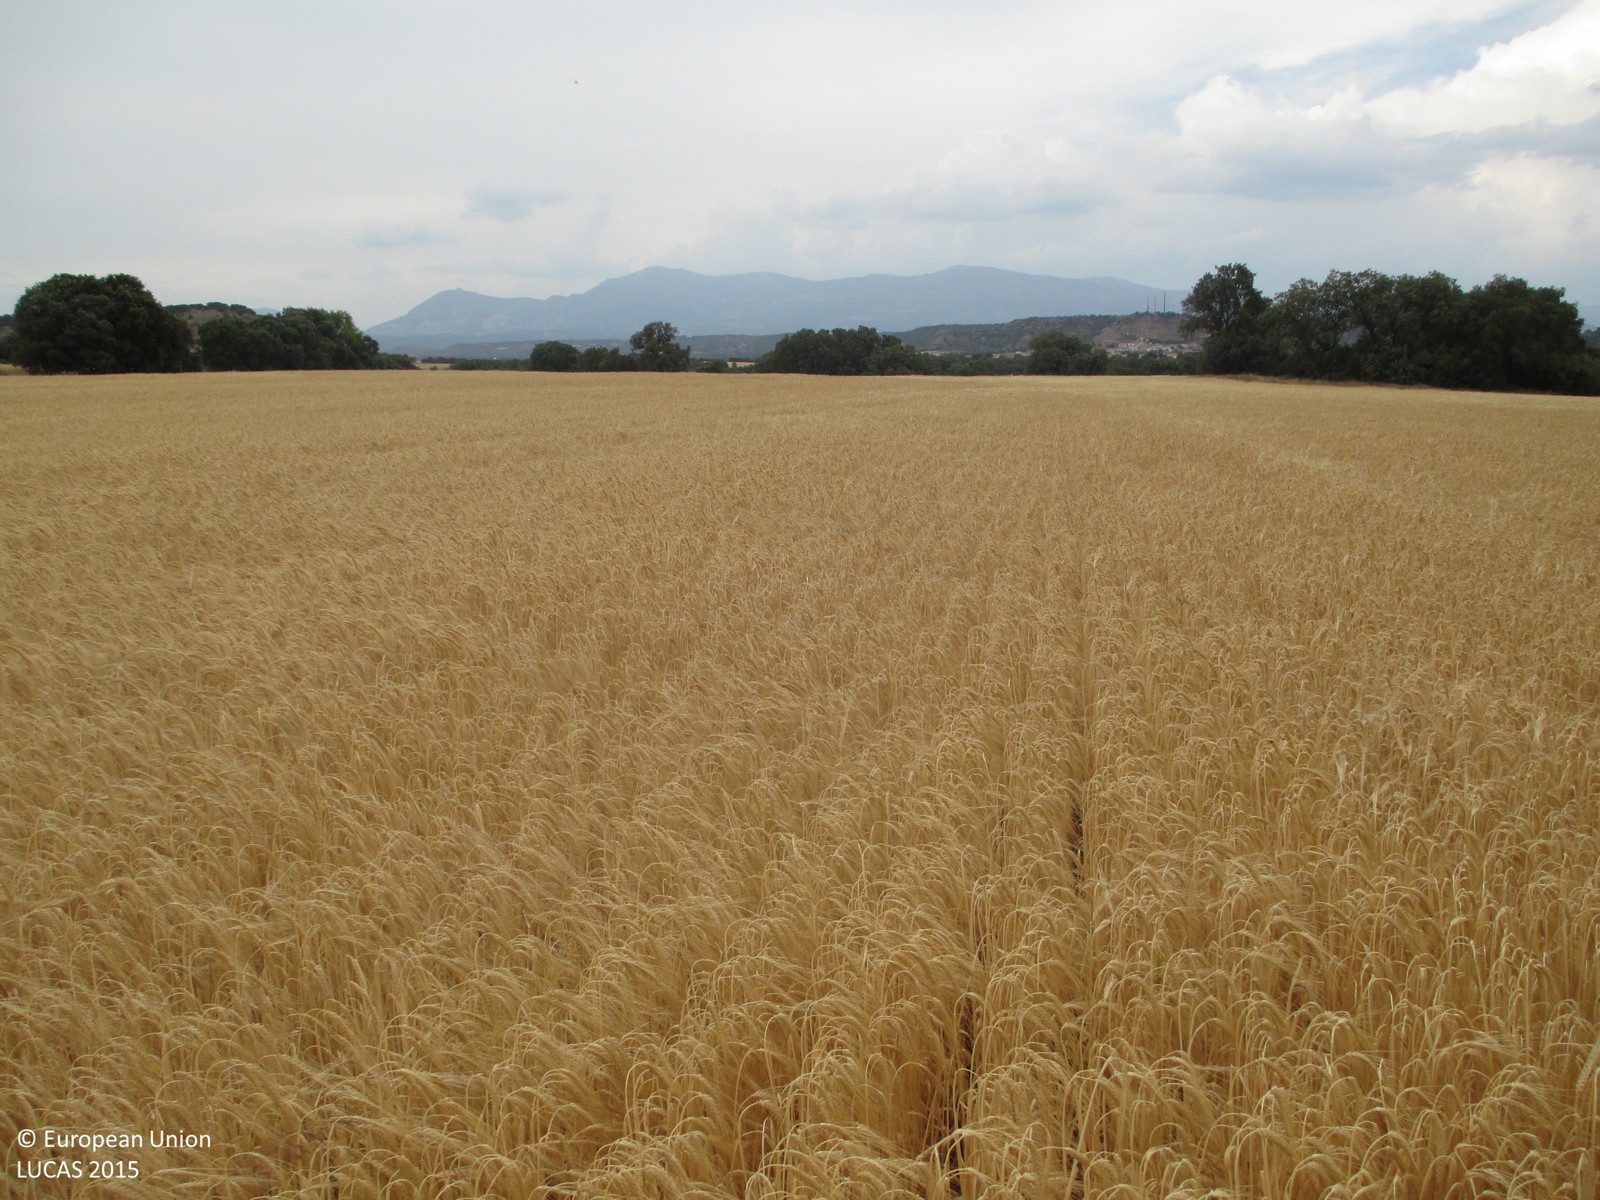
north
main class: Cropland
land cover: Barley
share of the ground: > 75 %
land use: Agriculture (excluding fallow land and kitchen gardens)
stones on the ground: < 10 %
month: May
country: ES
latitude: 42.1000
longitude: -0.2142
